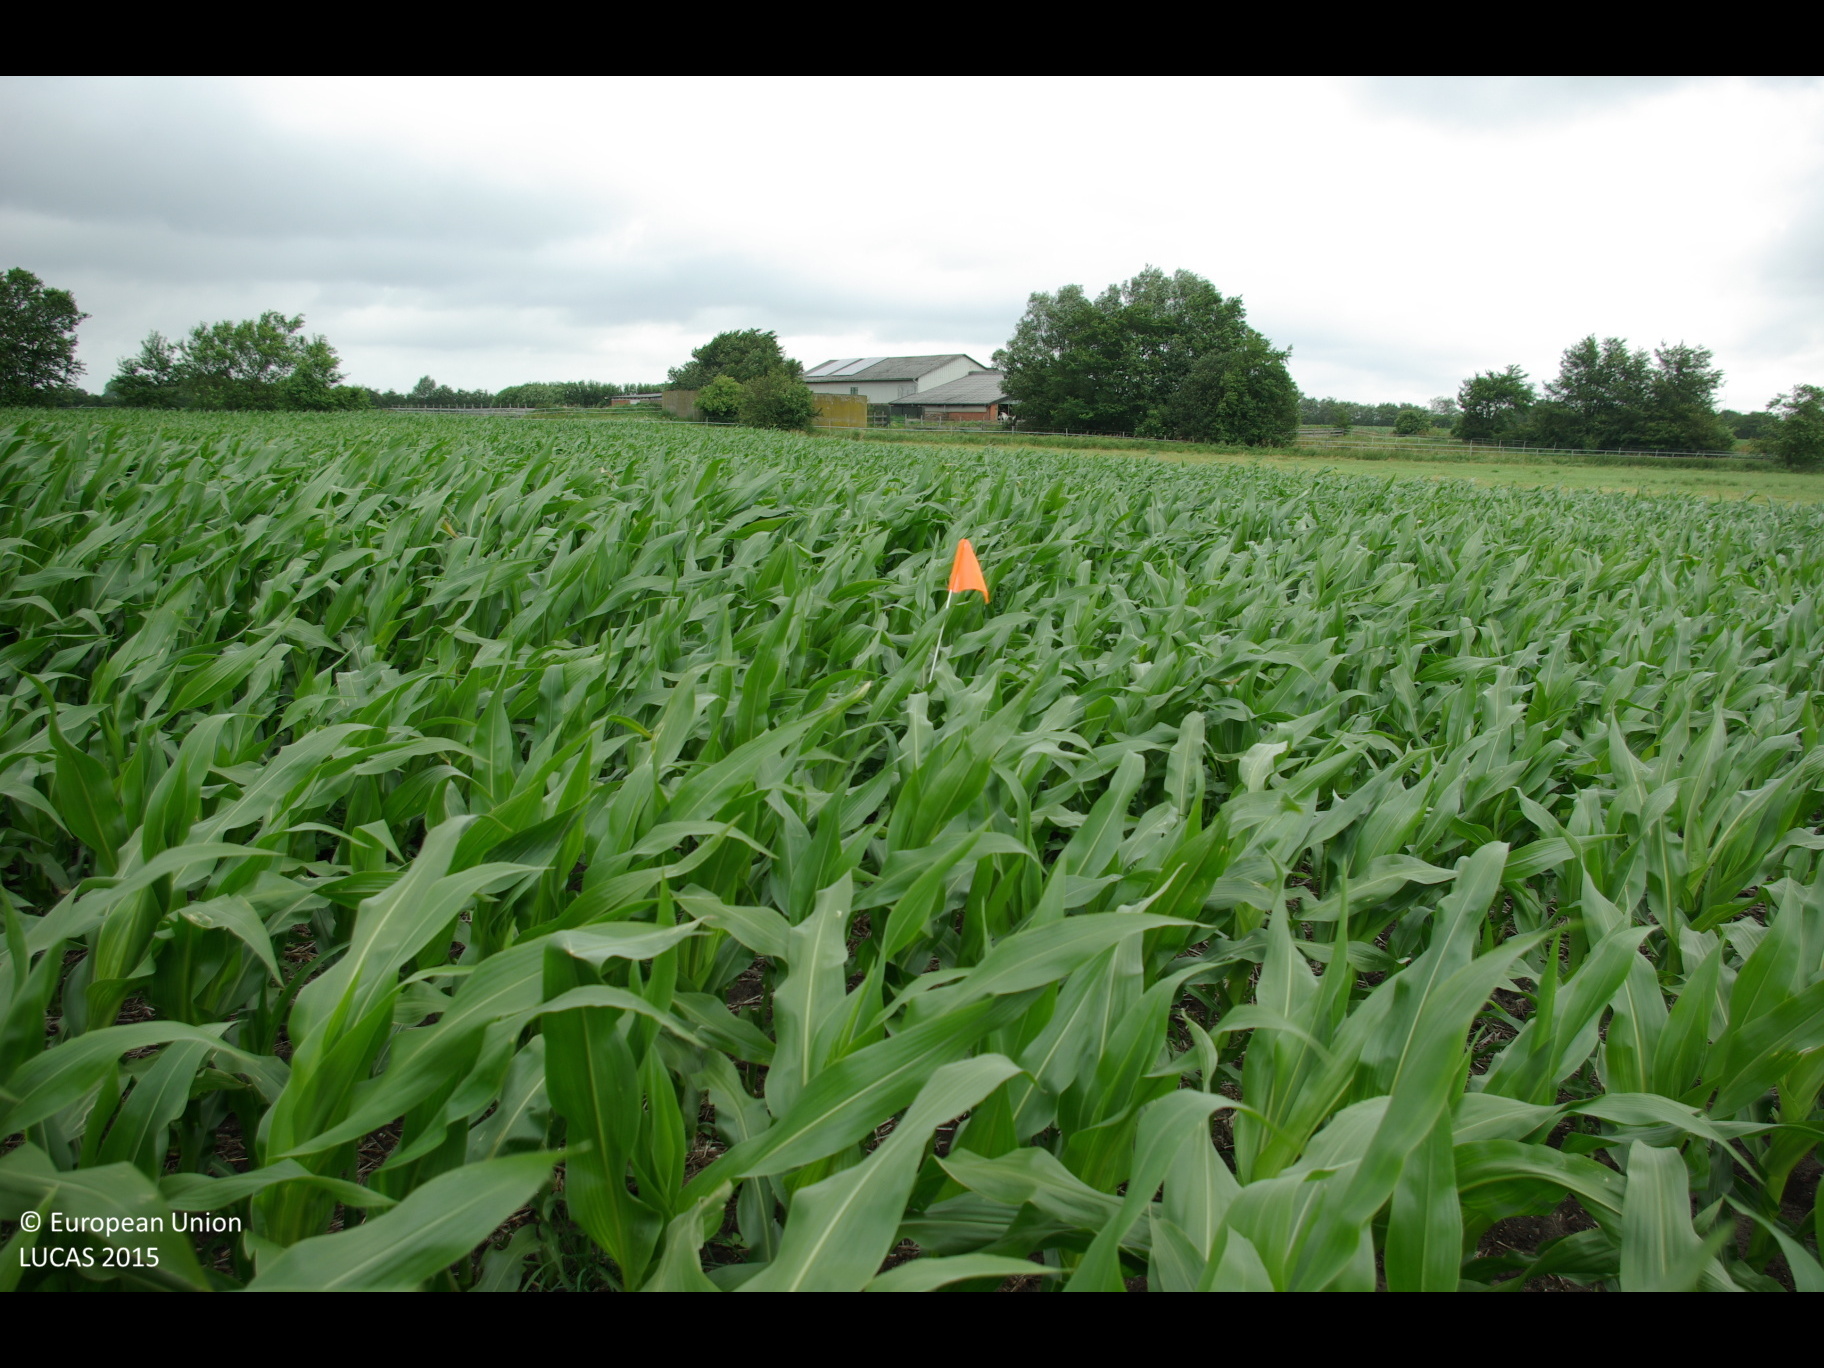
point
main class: Cropland
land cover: Maize
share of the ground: > 75 %
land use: Agriculture (excluding fallow land and kitchen gardens)
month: July
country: DE
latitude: 54.7479
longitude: 9.3014
